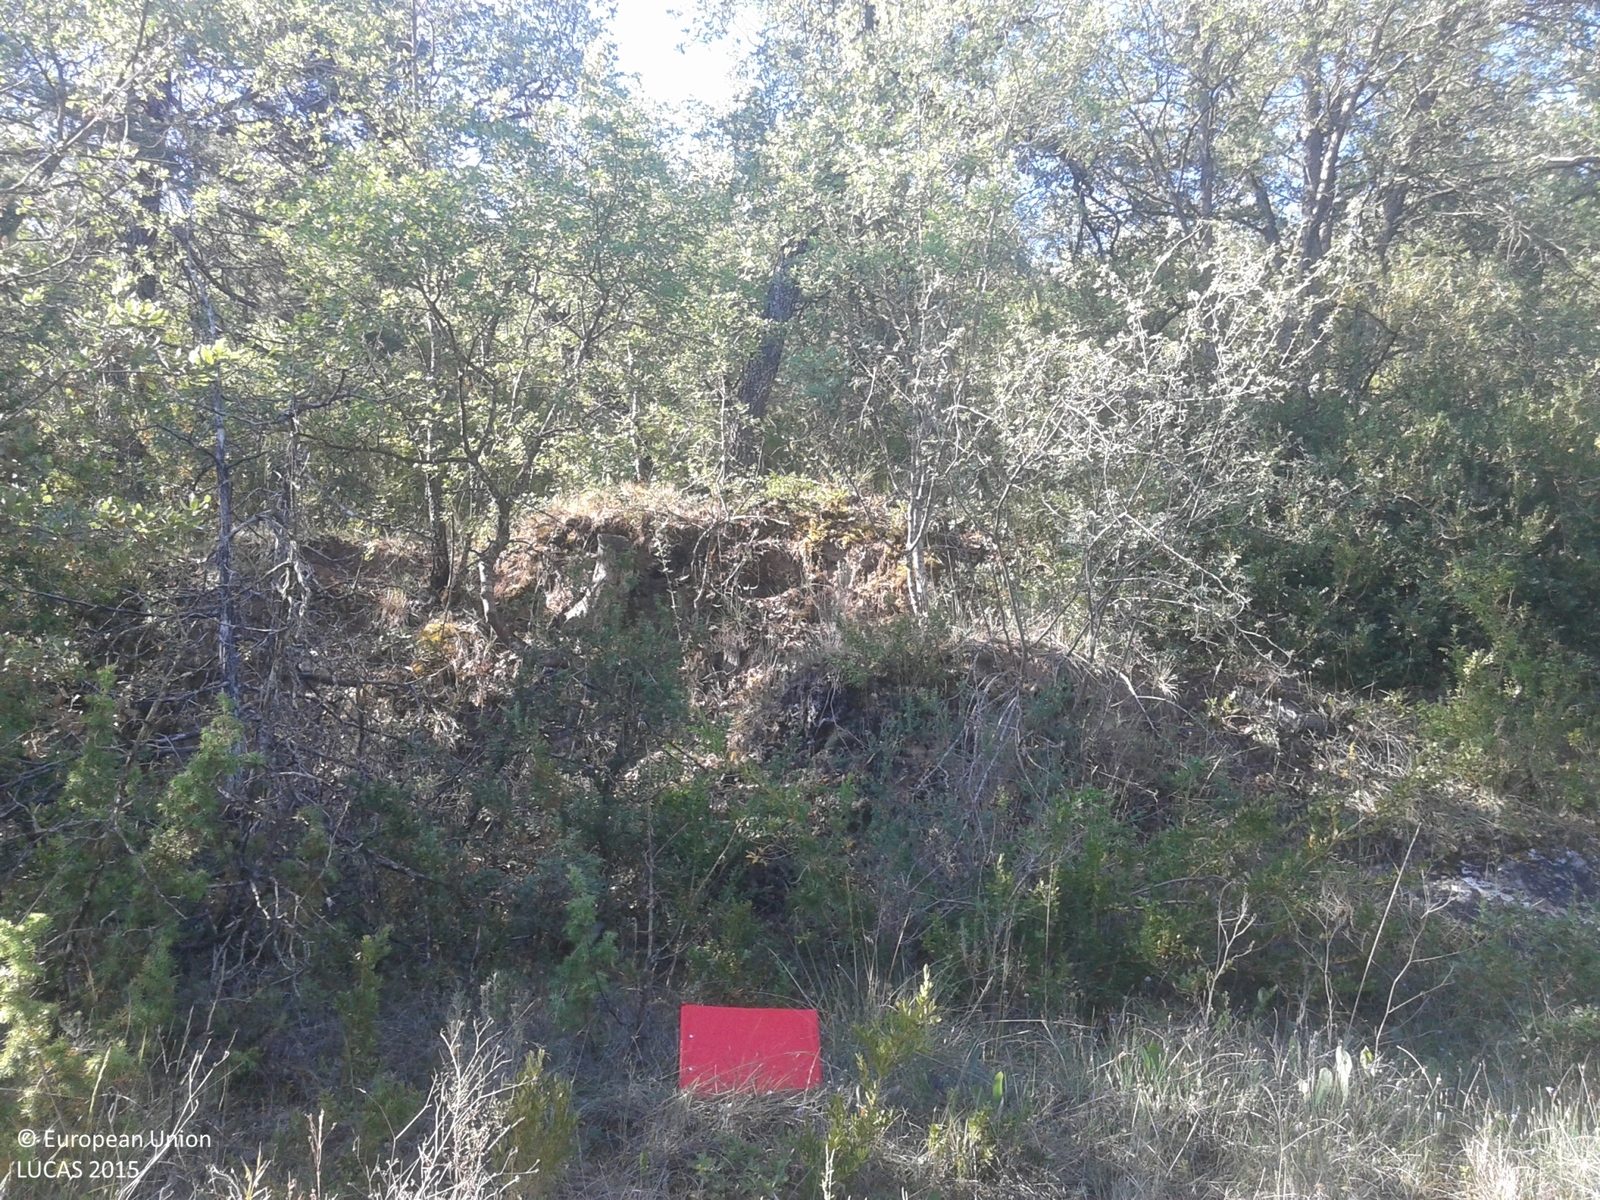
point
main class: Woodland
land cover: Broadleaved woodland
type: thermophilous deciduous forest
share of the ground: > 75 %
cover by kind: broadleaved forest trees 70 %, shrubs 15 %, coniferous forest trees 10 %, herbaceous plants 5 %
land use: Semi-natural and natural areas not in use
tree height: > 5 m
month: May
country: ES
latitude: 41.9008
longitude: 1.1279
